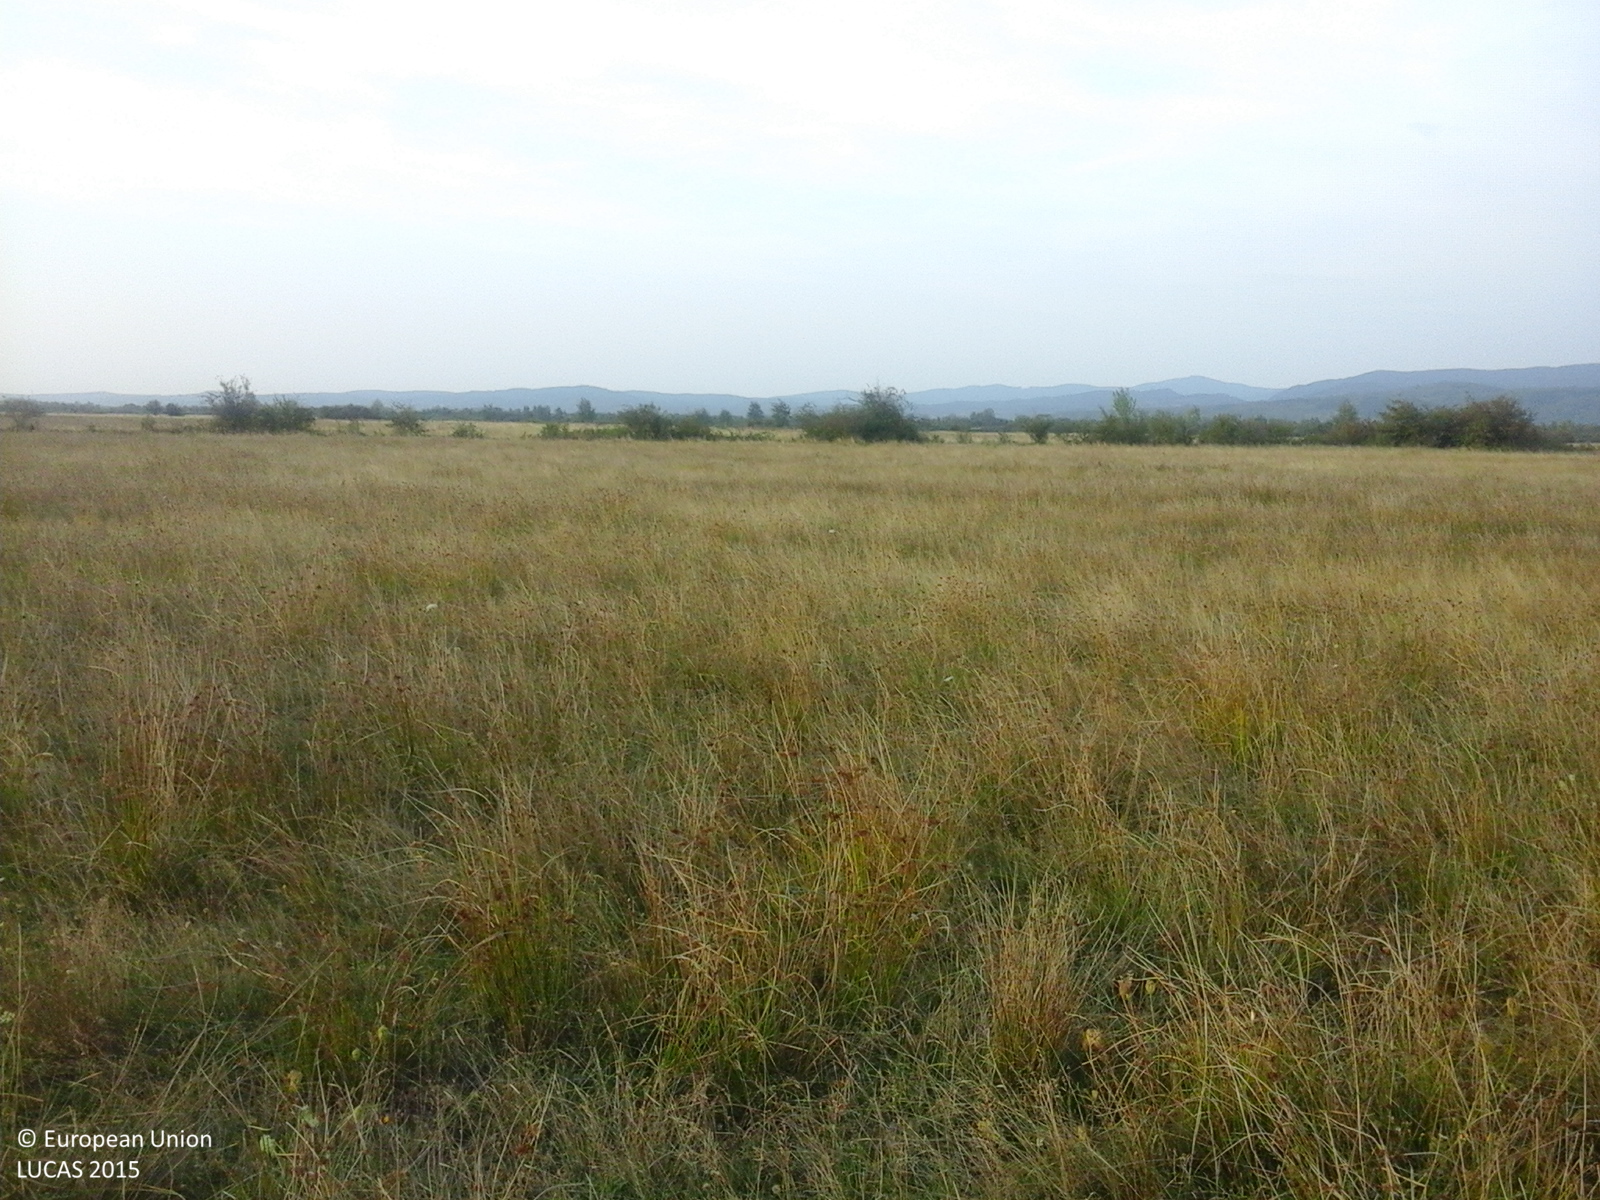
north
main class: Grassland
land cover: Grassland without tree/shrub cover
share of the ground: > 75 %
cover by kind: herbaceous plants 100 %
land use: Agriculture (excluding fallow land and kitchen gardens)
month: September
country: RO
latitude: 45.5707
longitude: 22.0979
